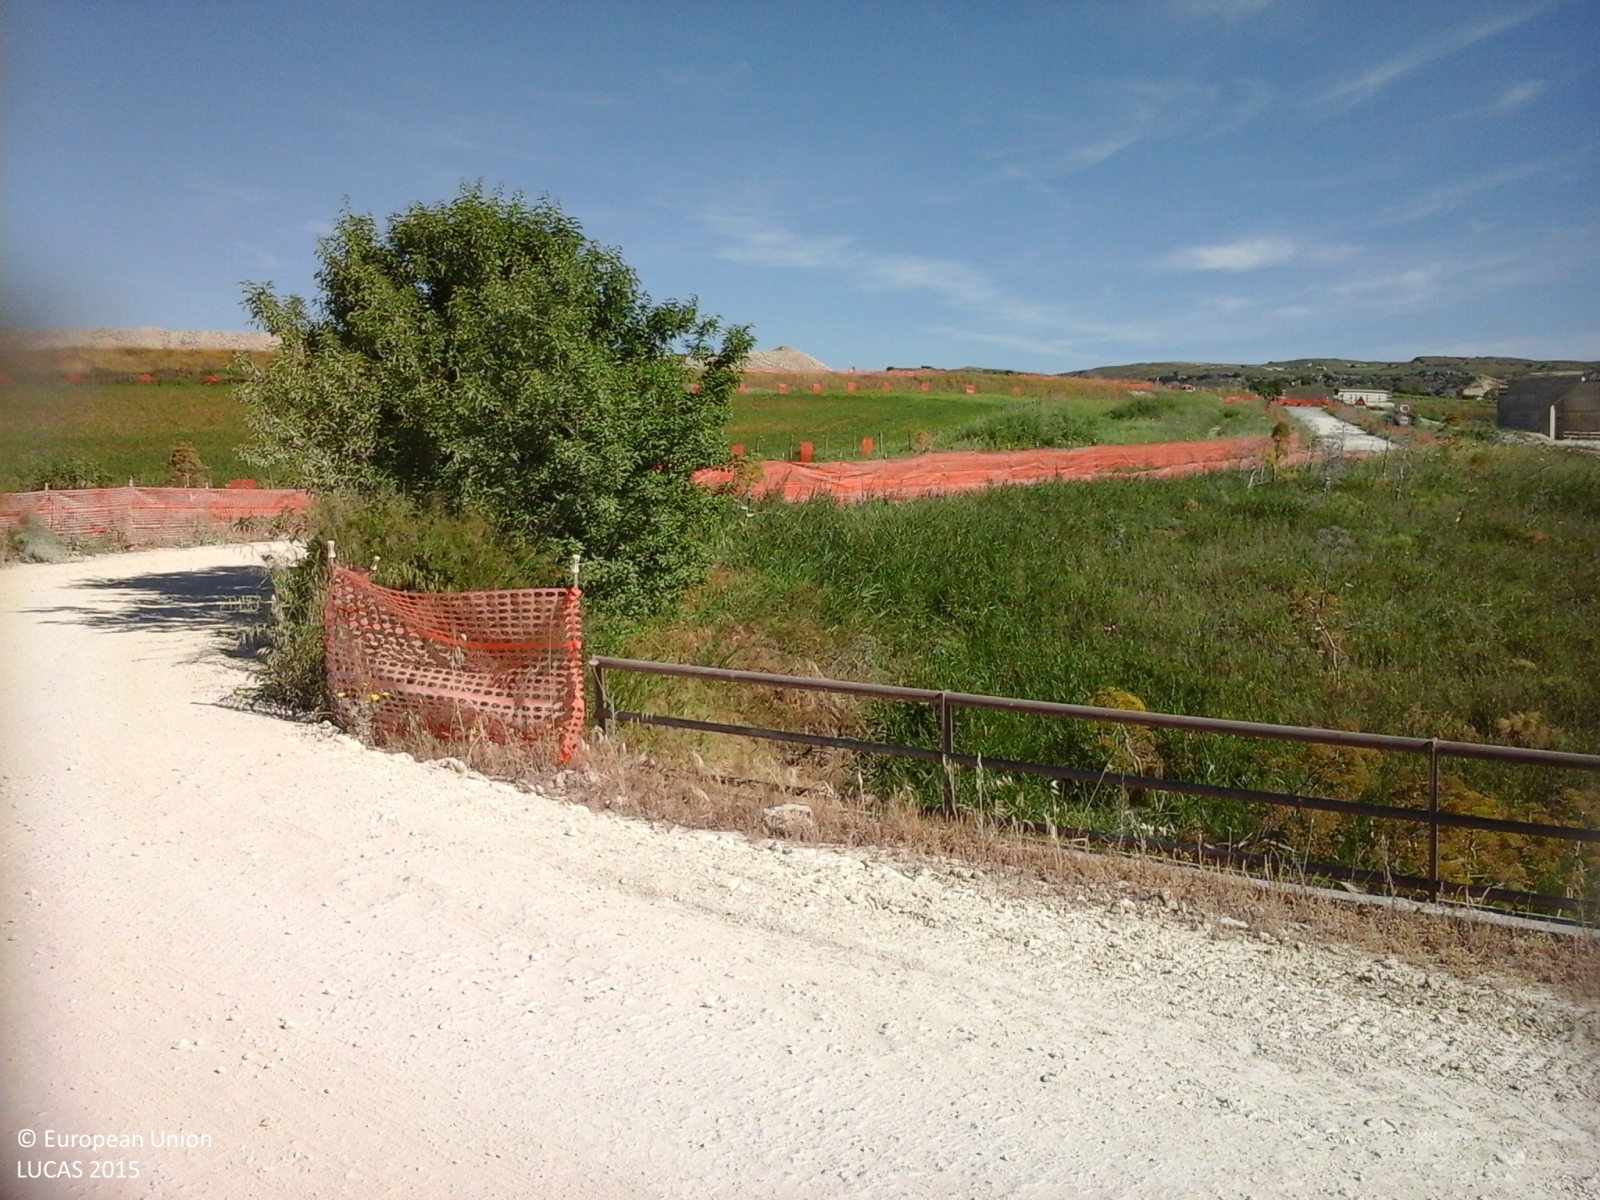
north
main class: Cropland
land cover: Durum wheat
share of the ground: > 75 %
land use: Agriculture (excluding fallow land and kitchen gardens)
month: May
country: IT
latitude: 37.4298
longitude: 13.9368
